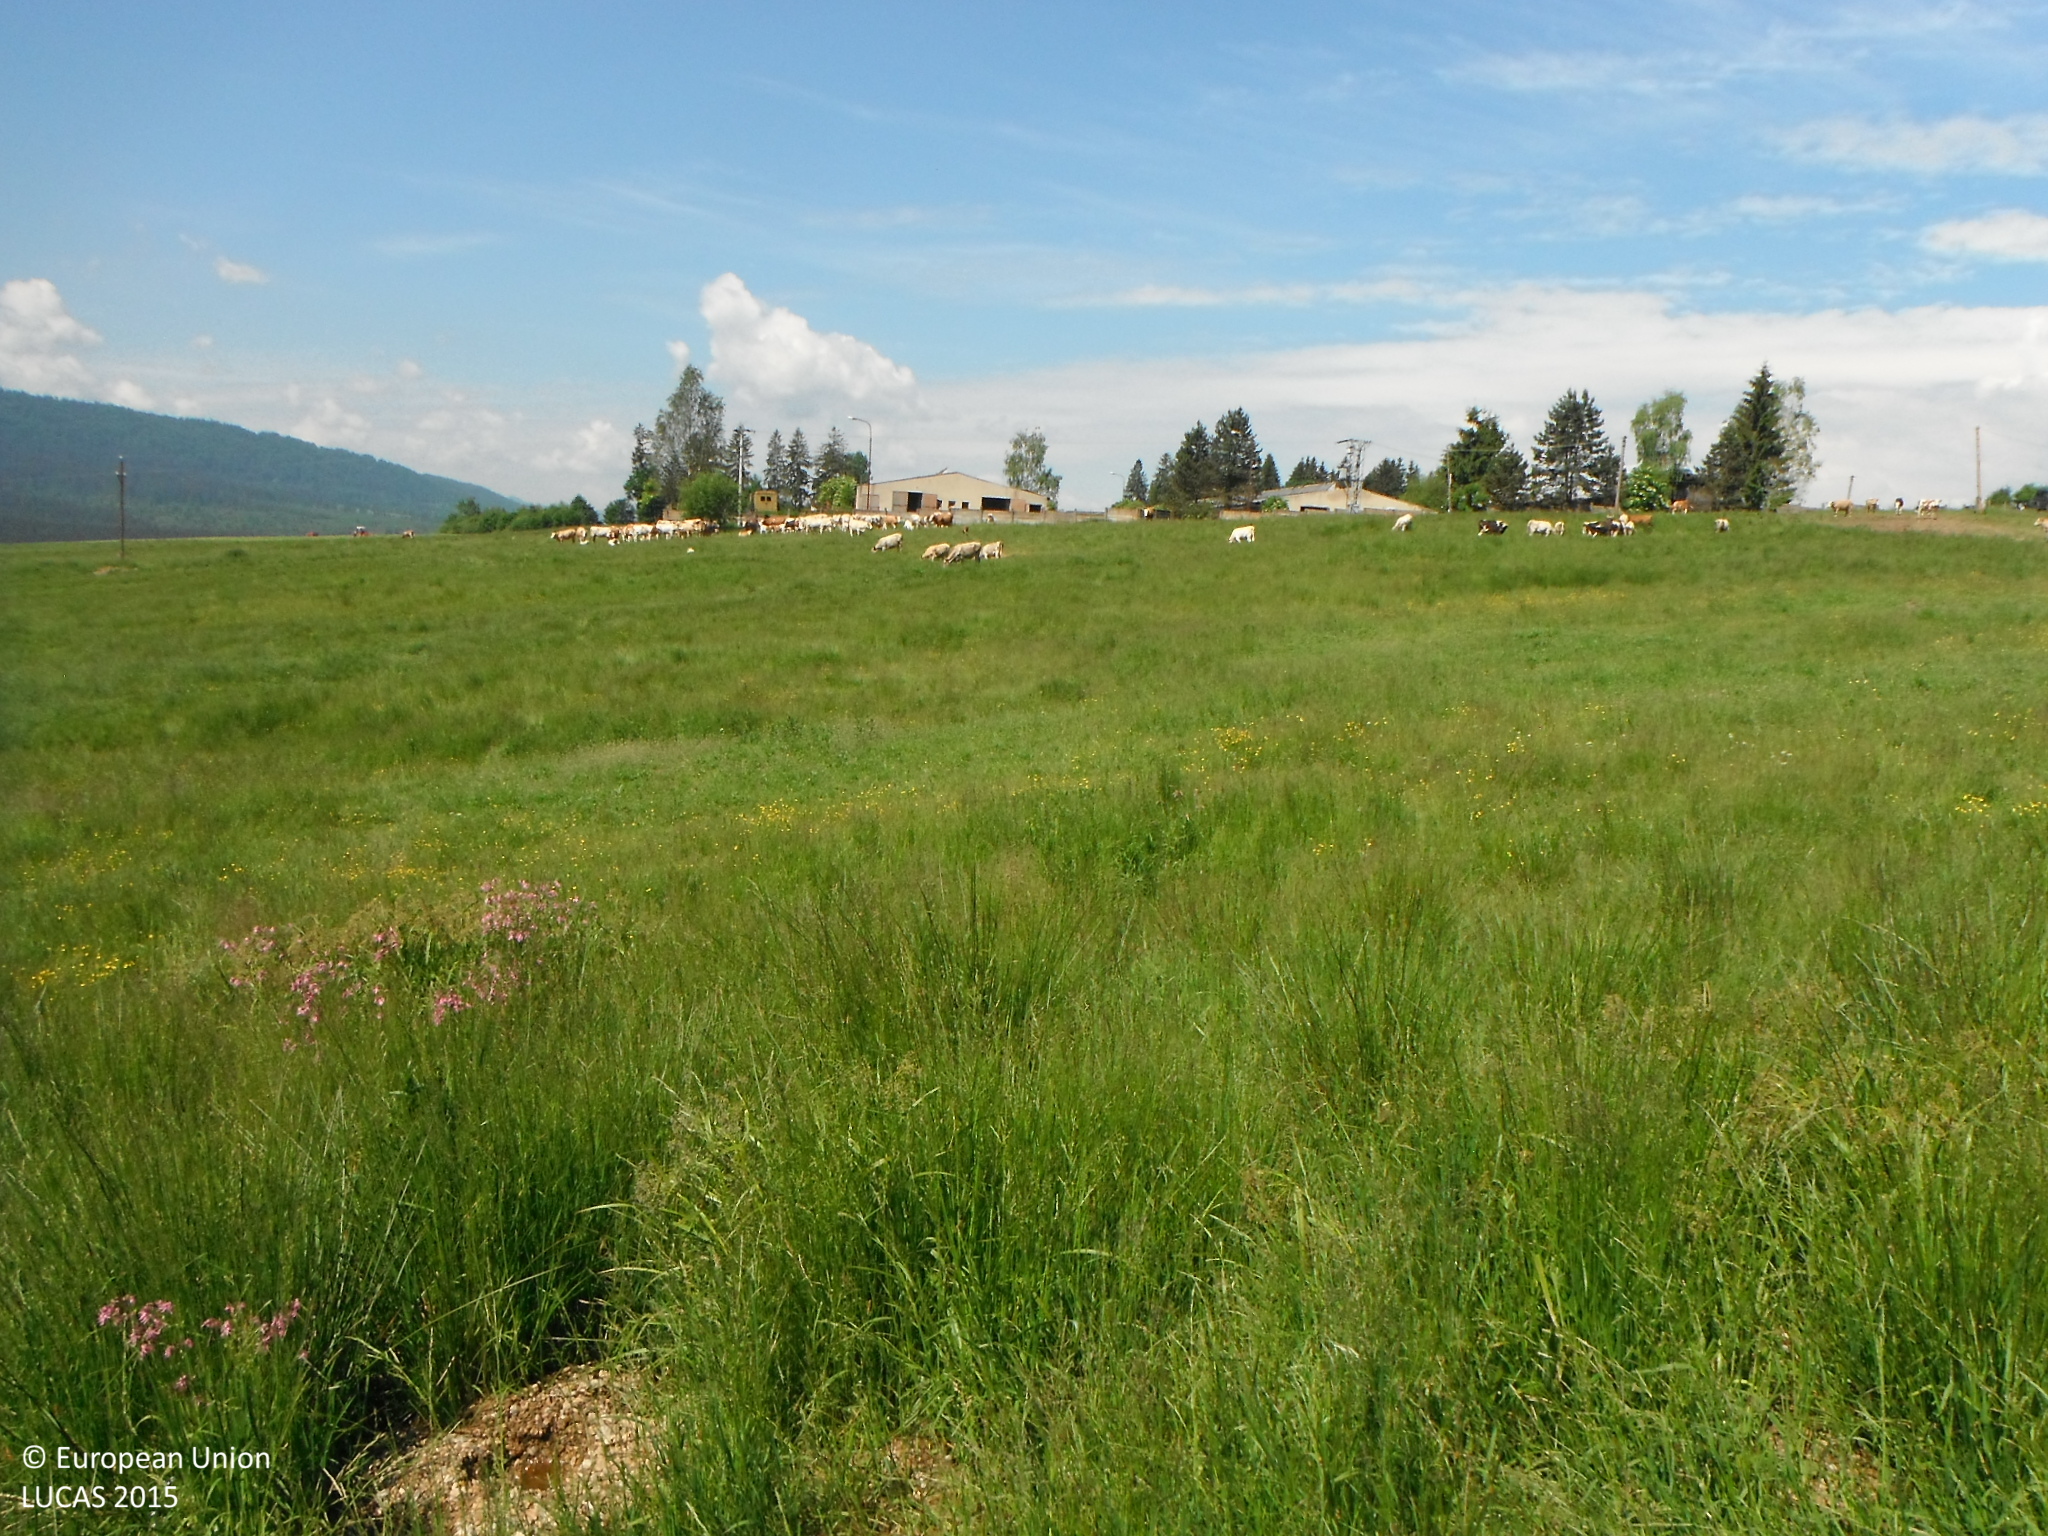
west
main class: Grassland
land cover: Grassland without tree/shrub cover
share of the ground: > 75 %
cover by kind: herbaceous plants 100 %
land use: Agriculture (excluding fallow land and kitchen gardens)
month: June
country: SK
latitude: 48.7863
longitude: 19.7595
